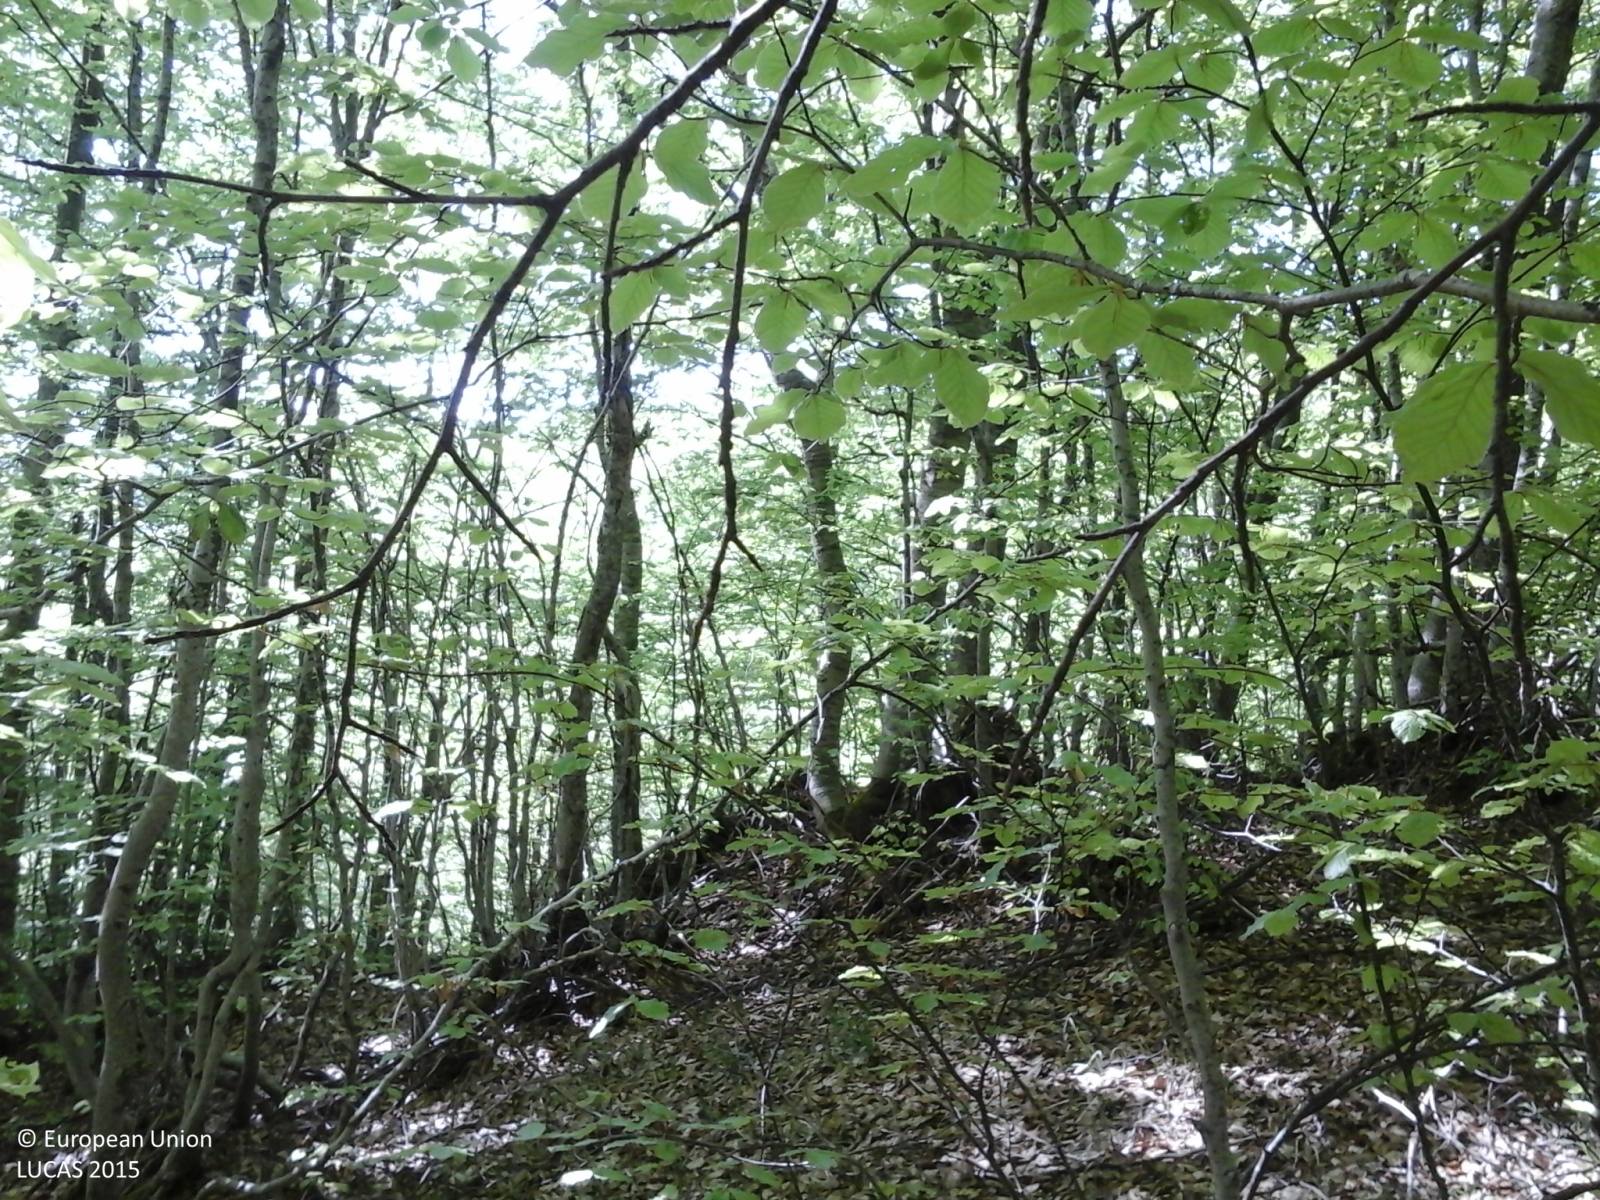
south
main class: Woodland
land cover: Broadleaved woodland
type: mountainous beech forest
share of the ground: > 75 %
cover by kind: broadleaved forest trees 100 %
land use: Forestry
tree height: > 5 m
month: May
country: IT
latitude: 44.6722
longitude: 9.2070
